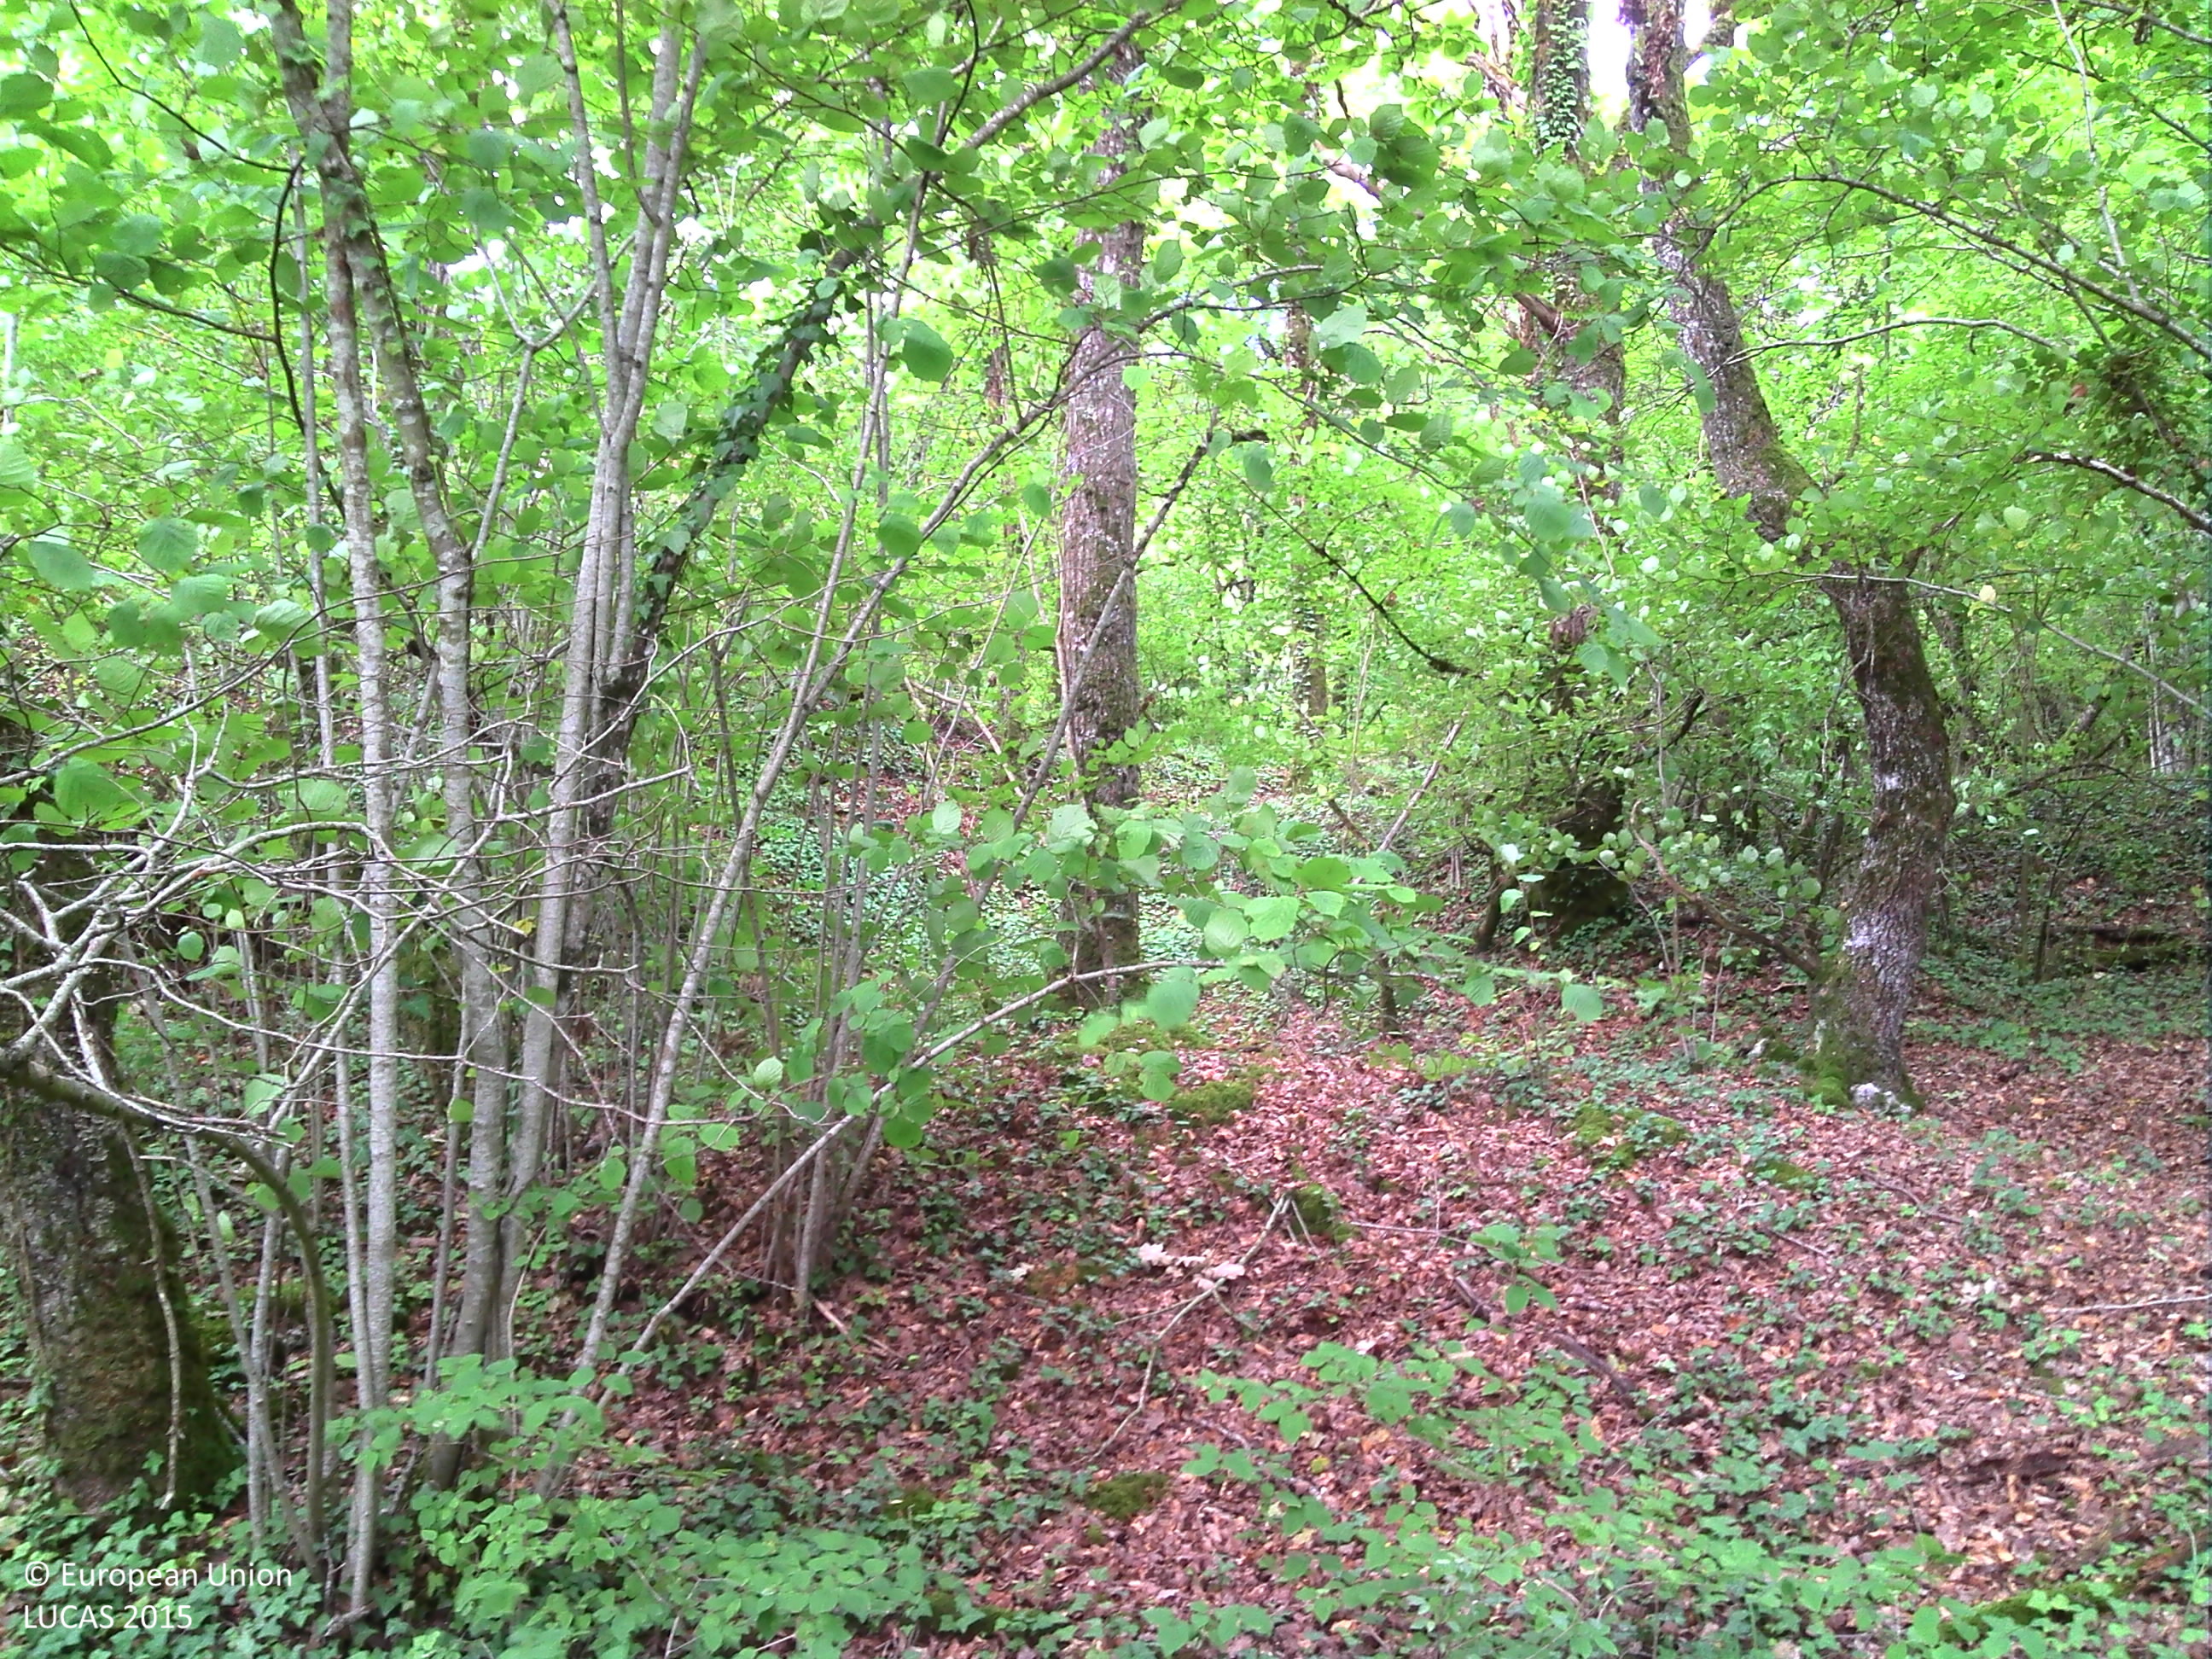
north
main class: Woodland
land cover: Broadleaved woodland
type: mesophytic deciduous forest
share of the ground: > 75 %
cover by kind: broadleaved forest trees 80 %, herbaceous plants 10 %, shrubs 5 %, lichens and mosses 5 %
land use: Forestry
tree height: > 5 m
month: September
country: FR
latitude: 48.2201
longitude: 4.6545
